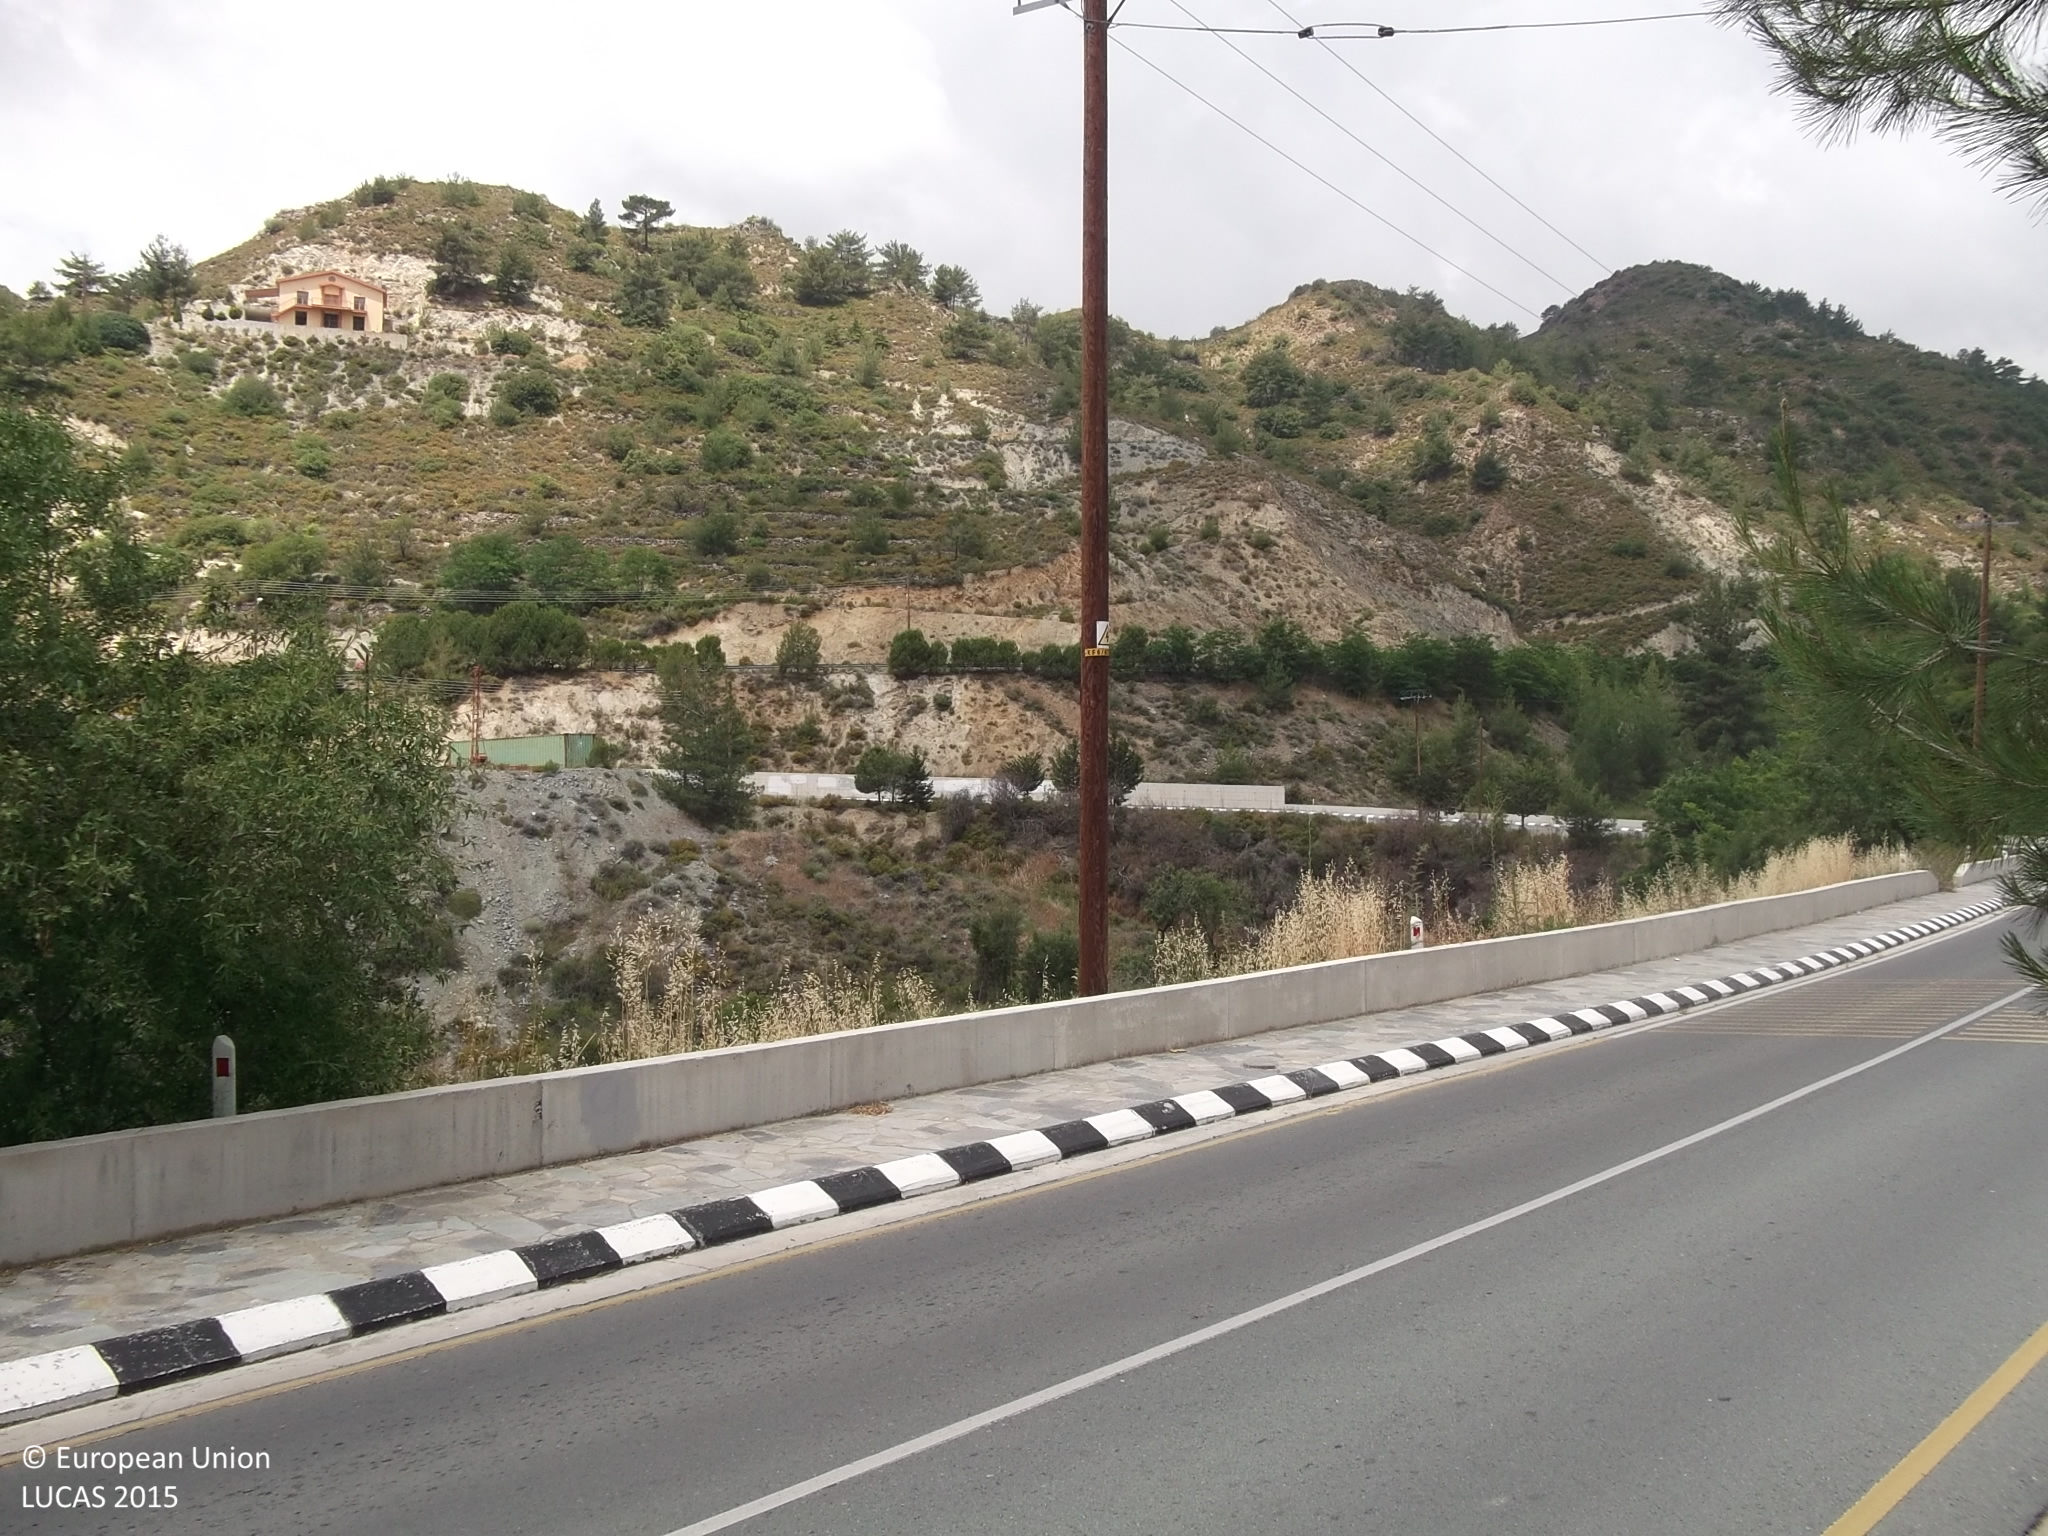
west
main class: Cropland
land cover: Nuts trees
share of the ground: 25 - 50 %
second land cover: Grassland without tree/shrub cover
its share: > 75 %
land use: Agriculture (excluding fallow land and kitchen gardens)
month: June
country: CY
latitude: 34.8971
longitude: 32.9634
